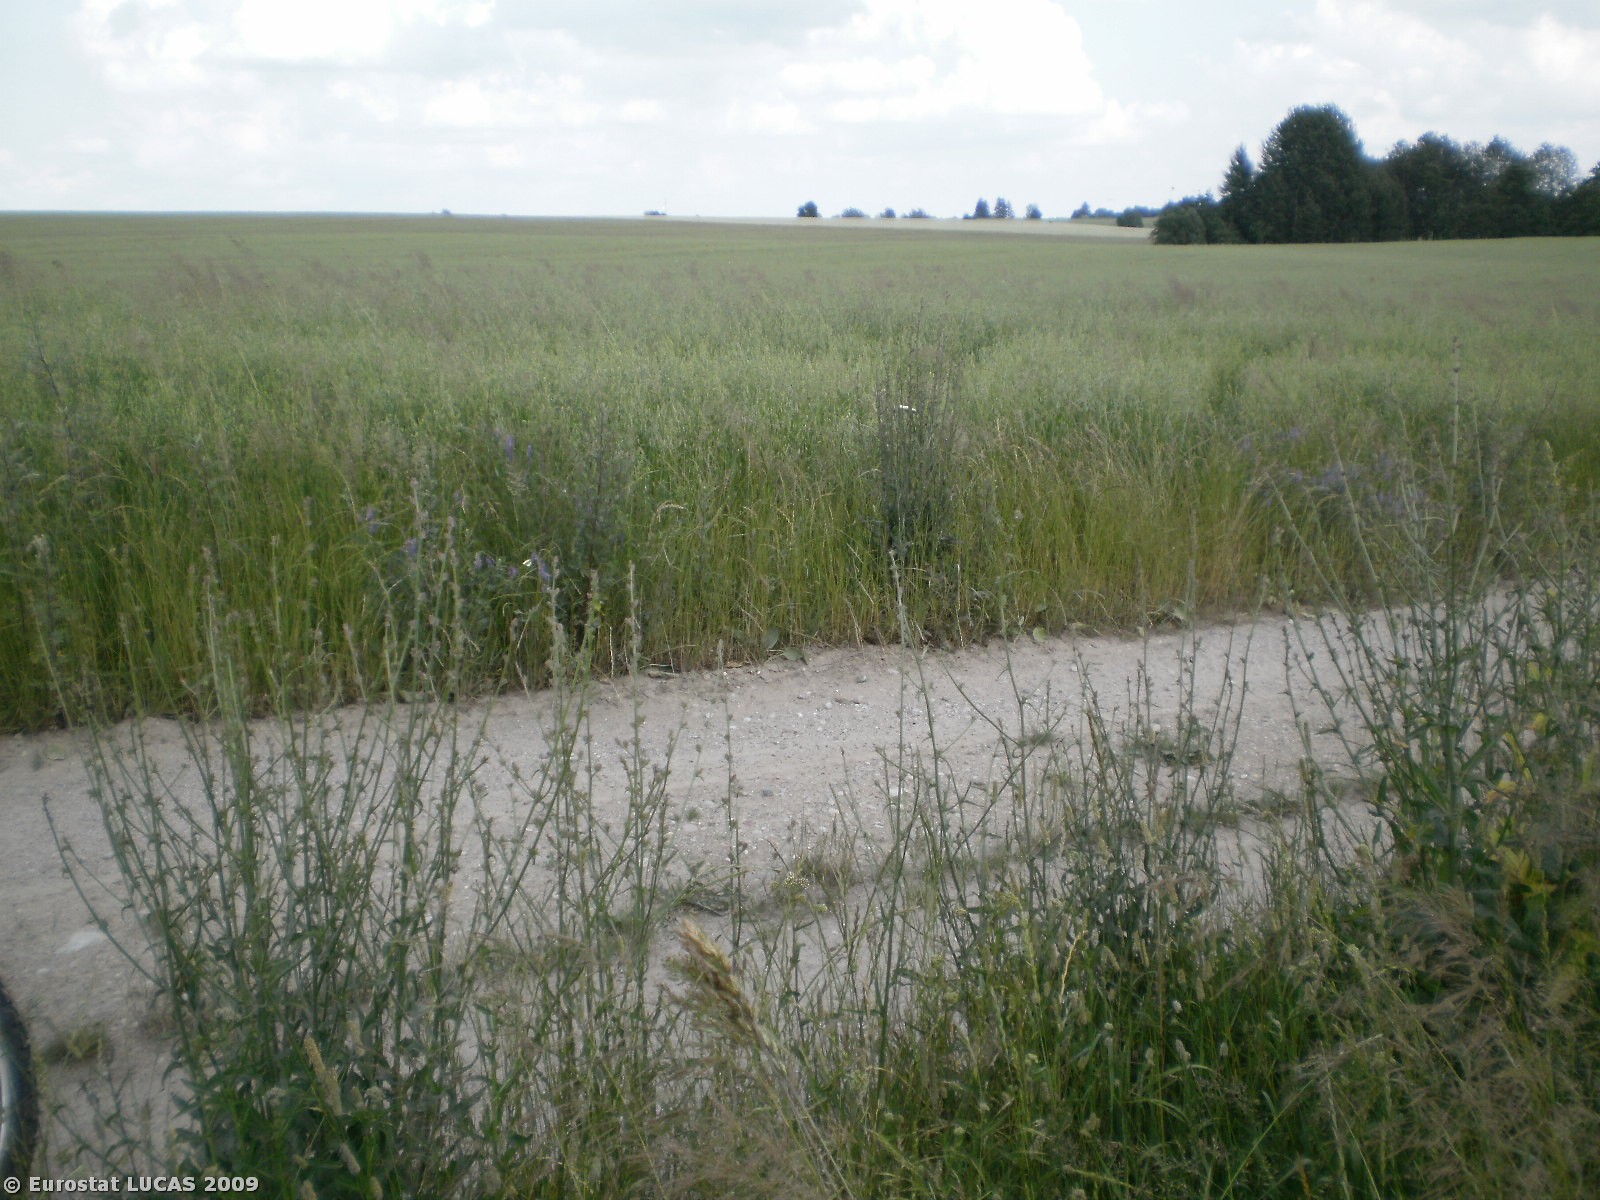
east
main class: Cropland
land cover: Oats
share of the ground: > 75 %
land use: Agriculture (excluding fallow land and kitchen gardens)
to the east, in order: Oats; Grass margins; Tracks; Grass margins; Oats
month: July
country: PL
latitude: 53.3300
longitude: 20.4424
